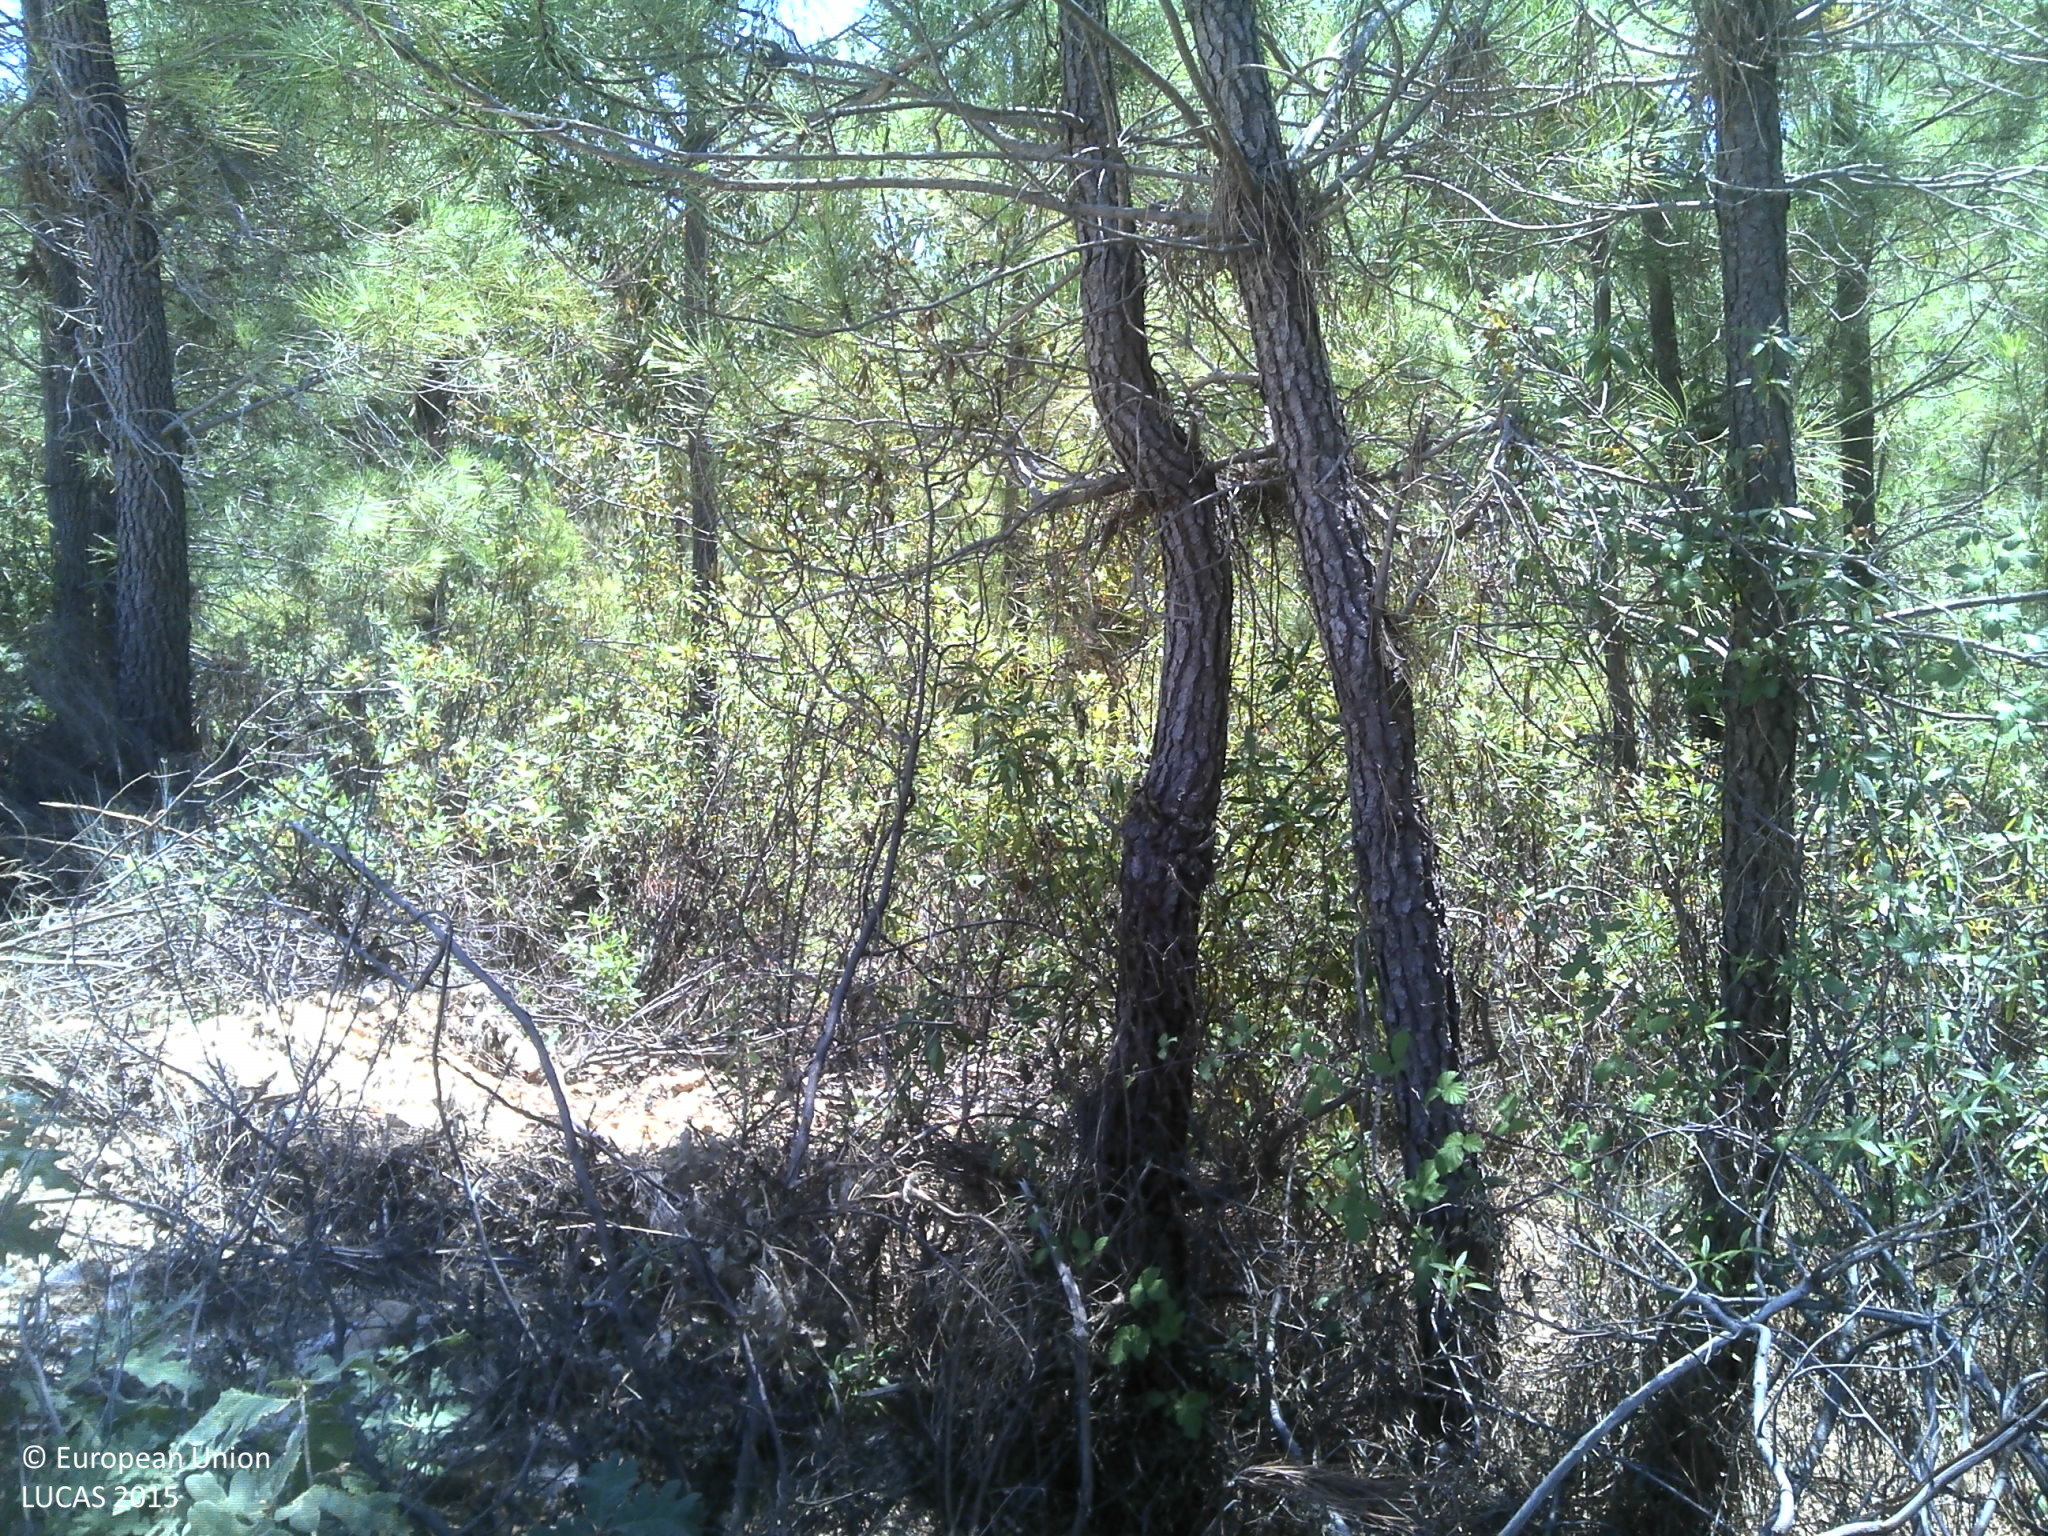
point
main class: Woodland
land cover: Pine dominated coniferous woodland
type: coniferous forest of the mediterranean region
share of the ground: 50 - 75 %
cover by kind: coniferous forest trees 70 %, shrubs 10 %, unconsolidated bare surface 10 %, herbaceous plants 5 %
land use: Forestry
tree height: > 5 m
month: June
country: PT
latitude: 40.0836
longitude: -7.0872
